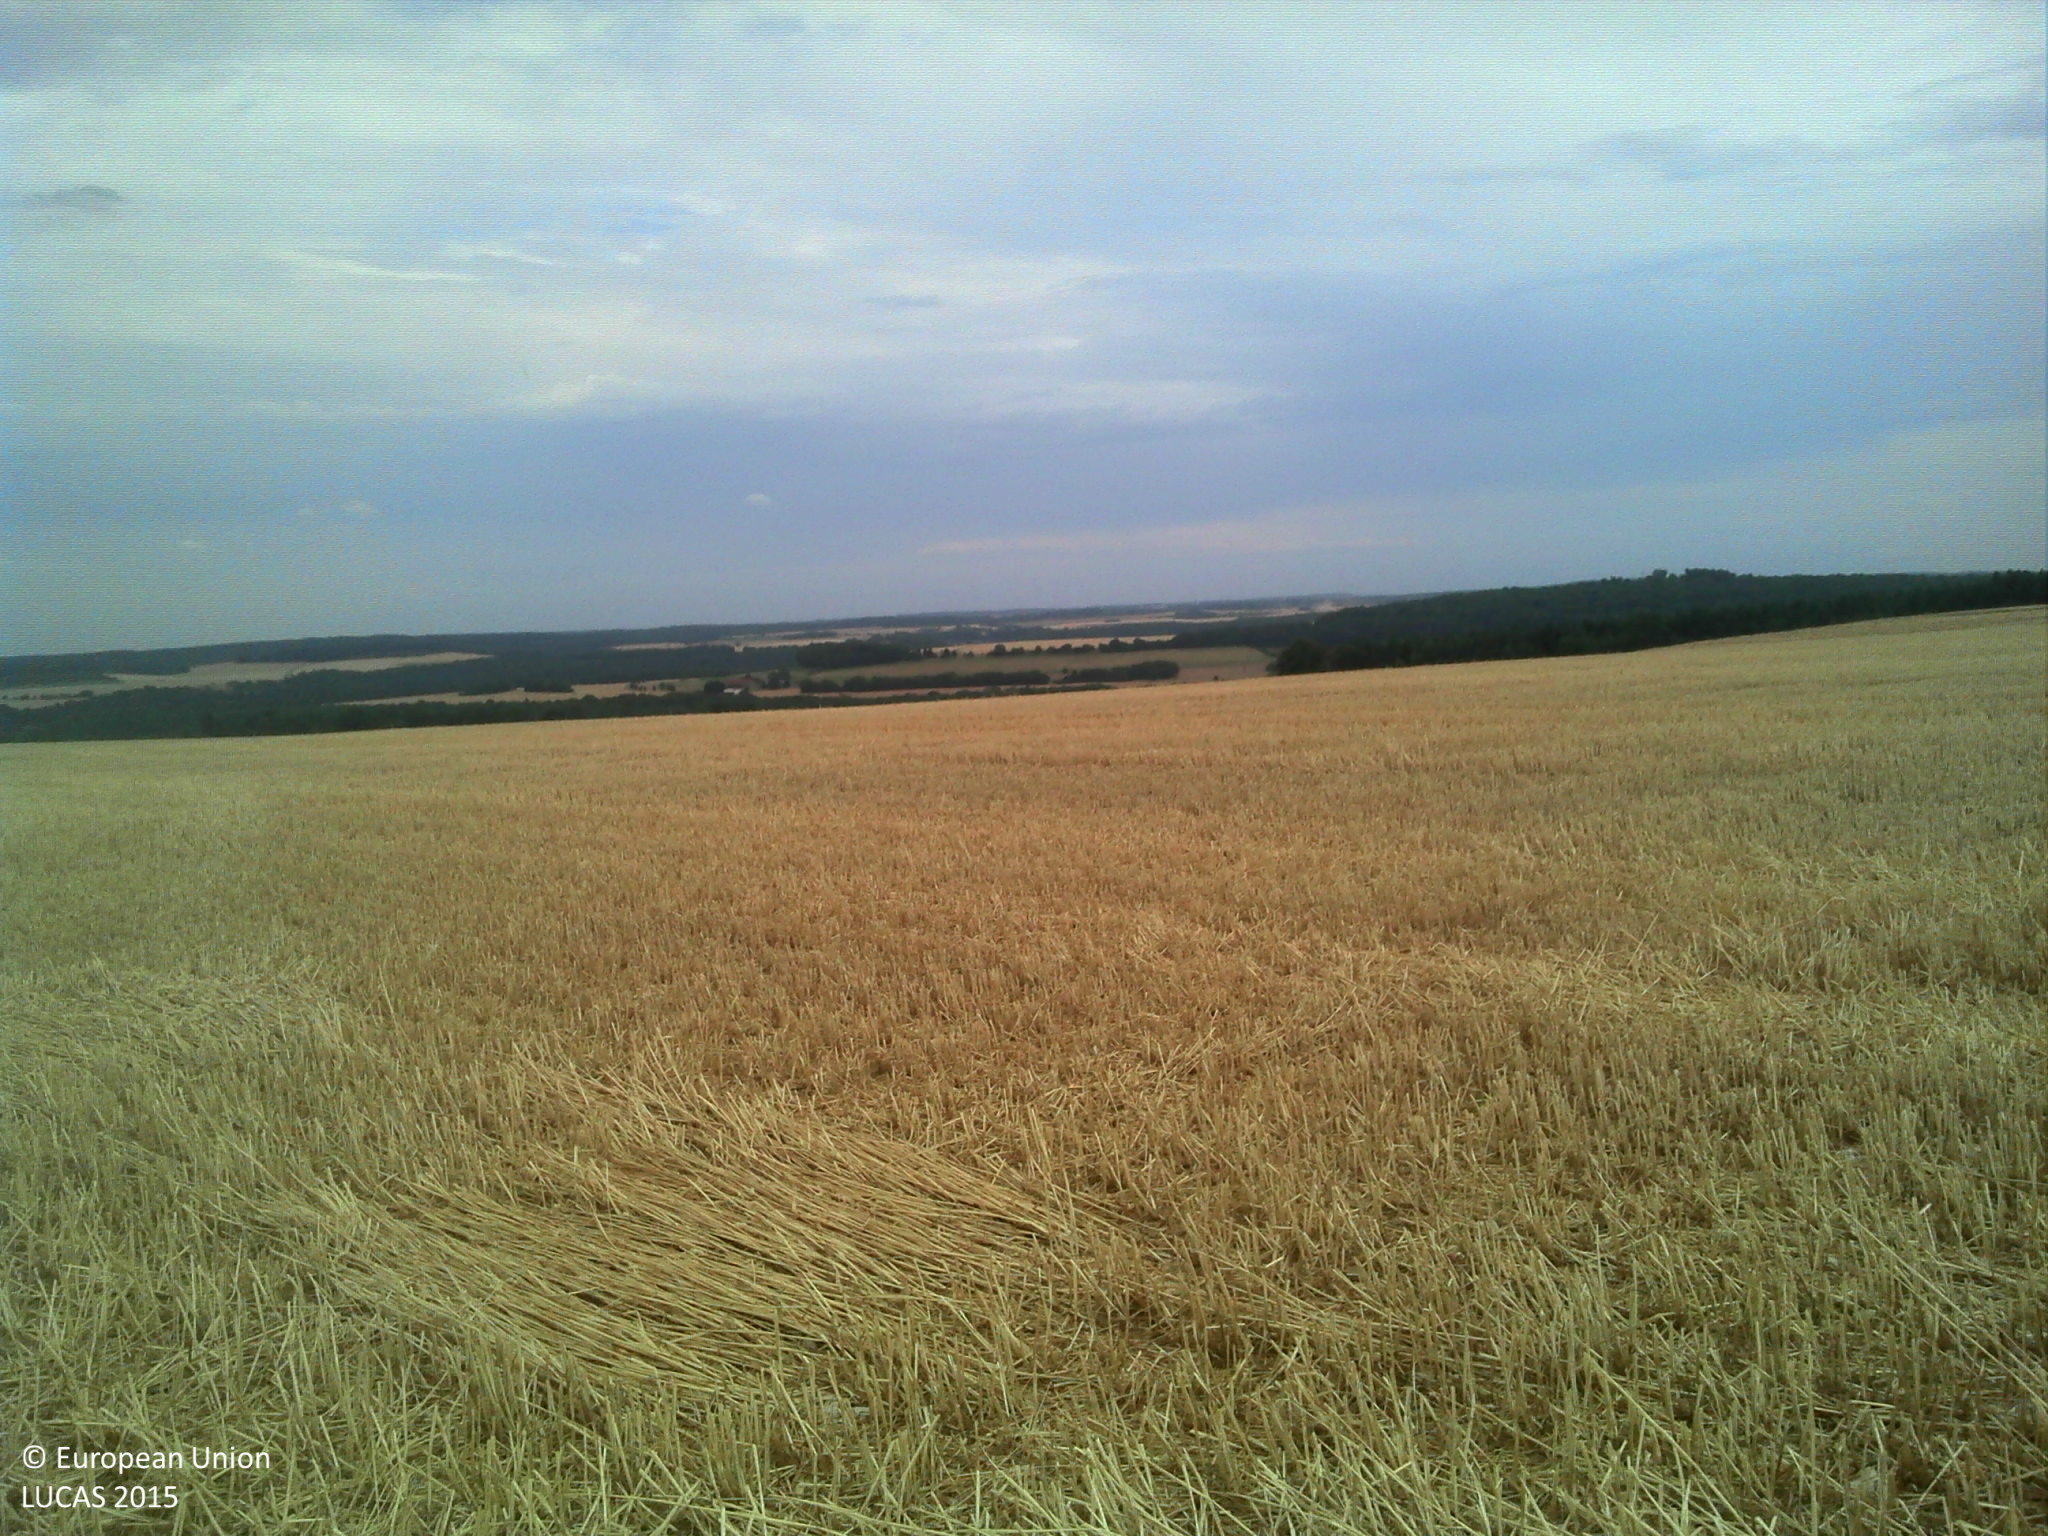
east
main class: Cropland
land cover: Common wheat
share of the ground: 10 - 25 %
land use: Agriculture (excluding fallow land and kitchen gardens)
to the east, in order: Common wheat
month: July
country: FR
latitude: 47.9935
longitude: 5.2154
